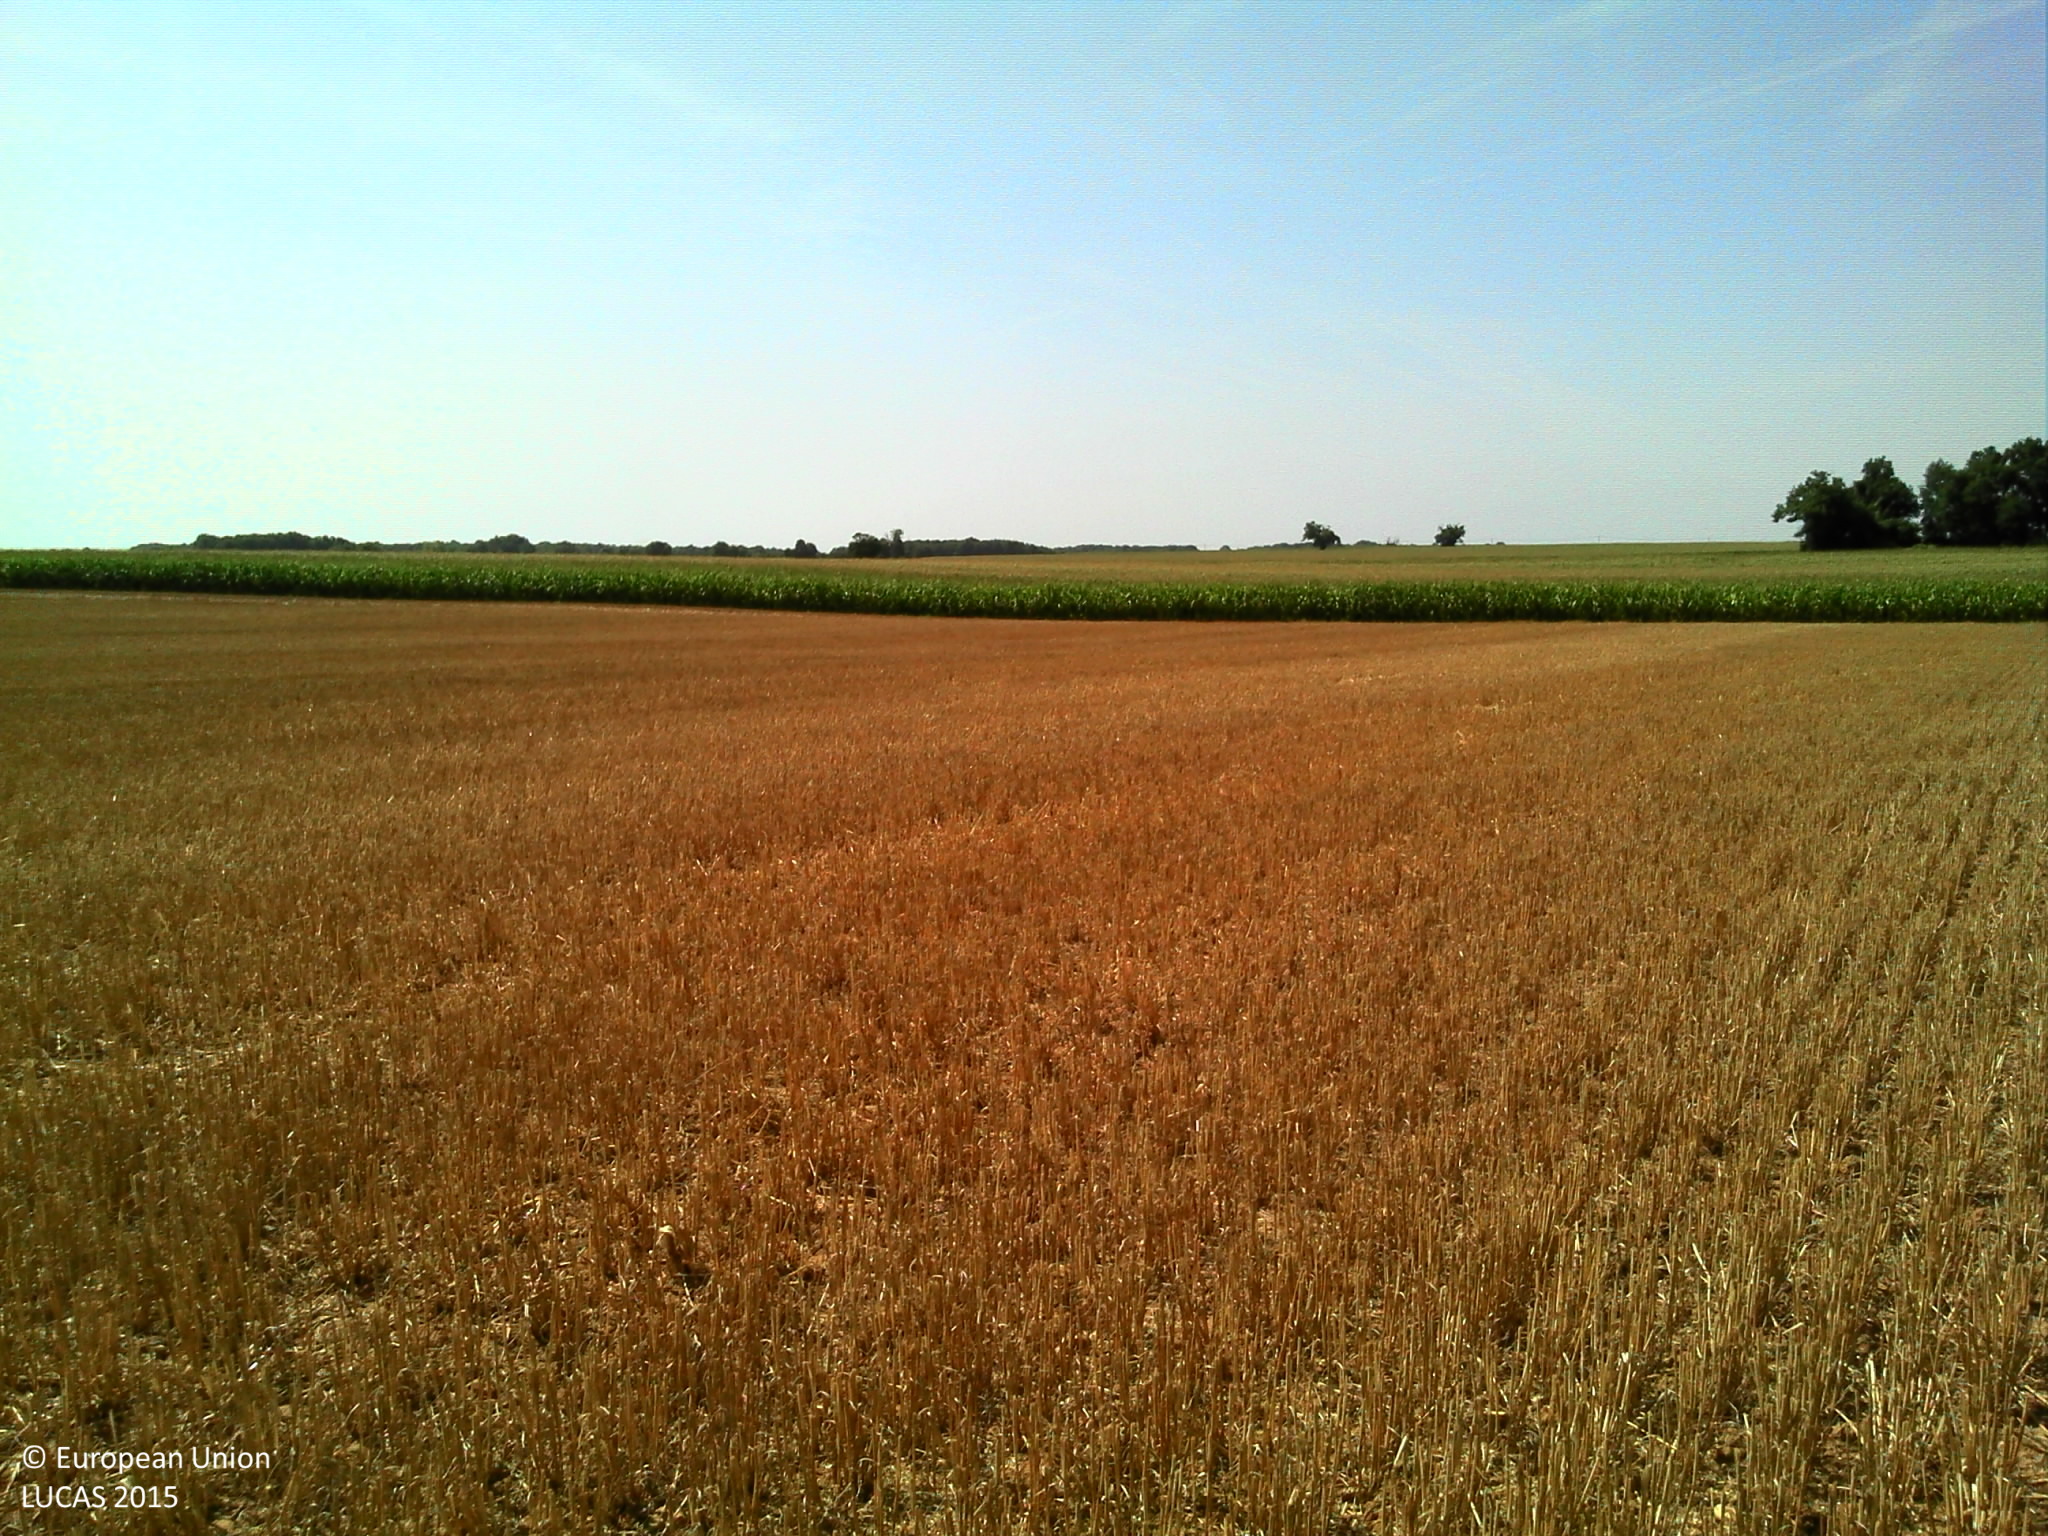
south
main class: Cropland
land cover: Common wheat
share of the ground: > 75 %
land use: Agriculture (excluding fallow land and kitchen gardens)
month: August
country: FR
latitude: 46.2222
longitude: 0.3500
